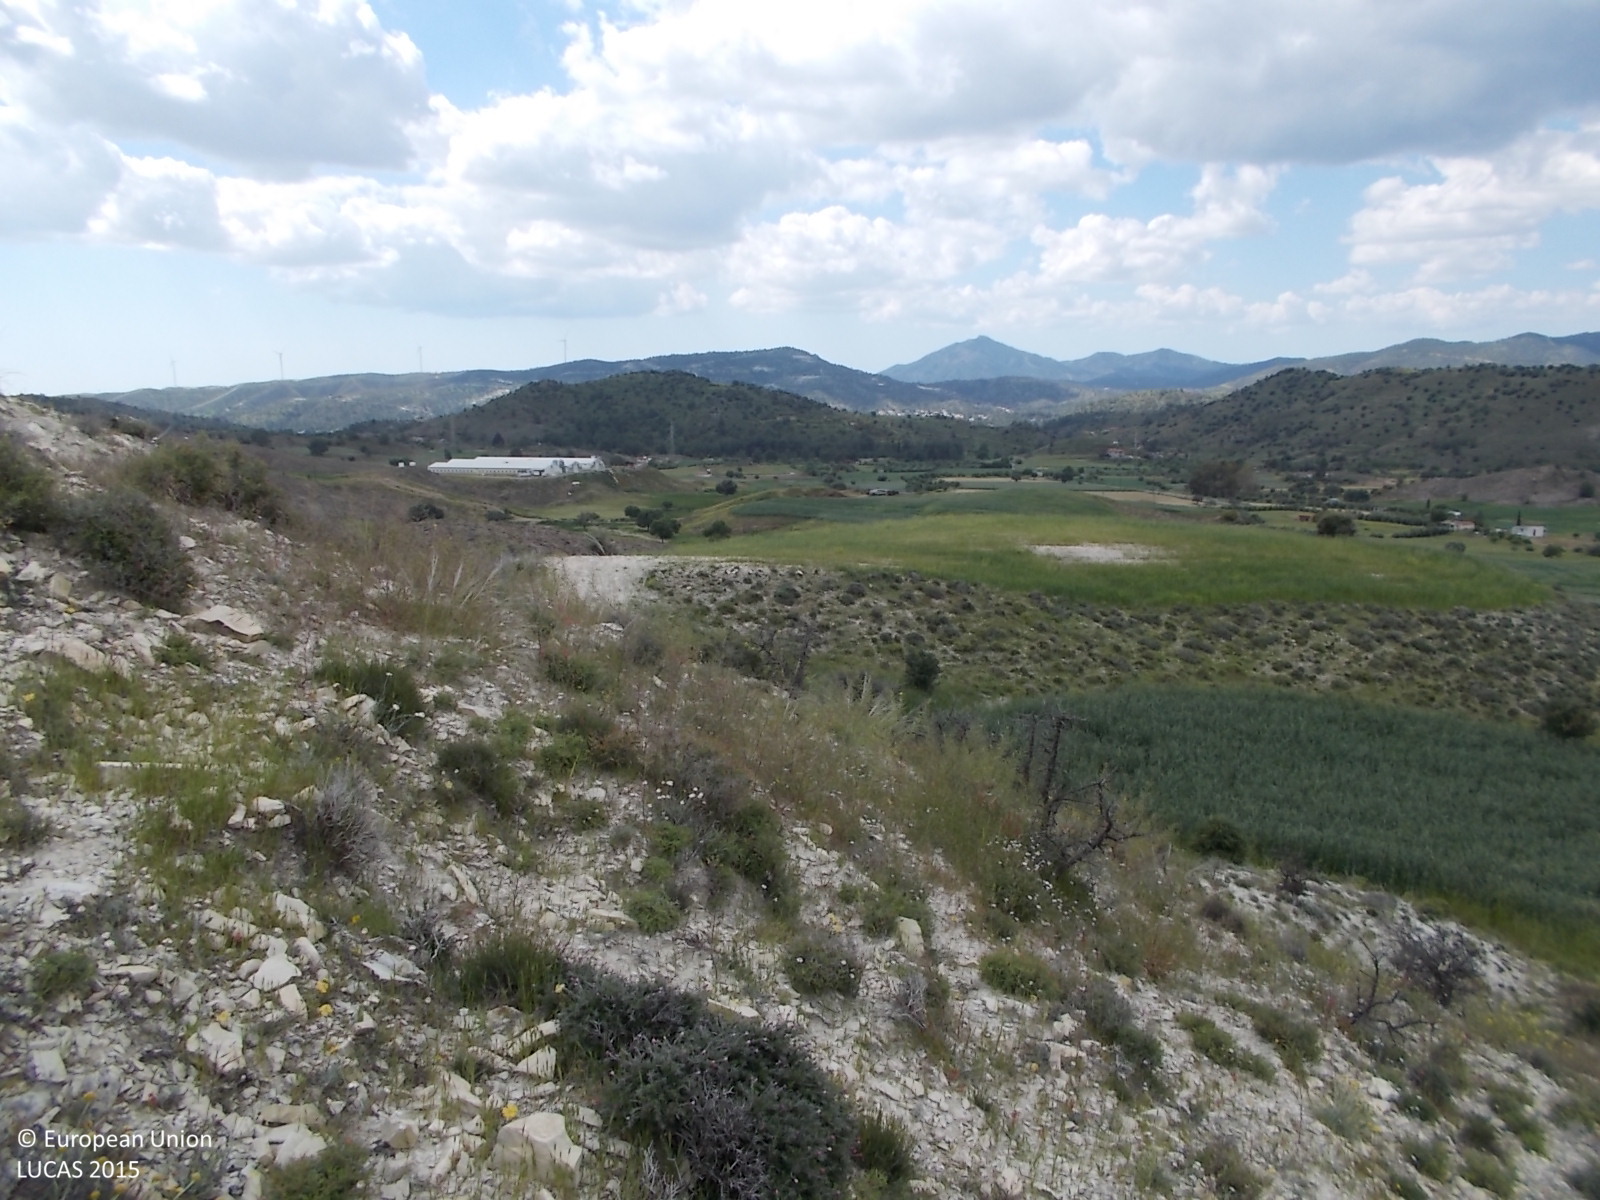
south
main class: Shrubland
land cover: Shrubland without tree cover
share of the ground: 25 - 50 %
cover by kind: unconsolidated bare surface 60 %, shrubs 40 %
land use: Semi-natural and natural areas not in use
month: April
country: CY
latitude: 34.9735
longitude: 33.4673
